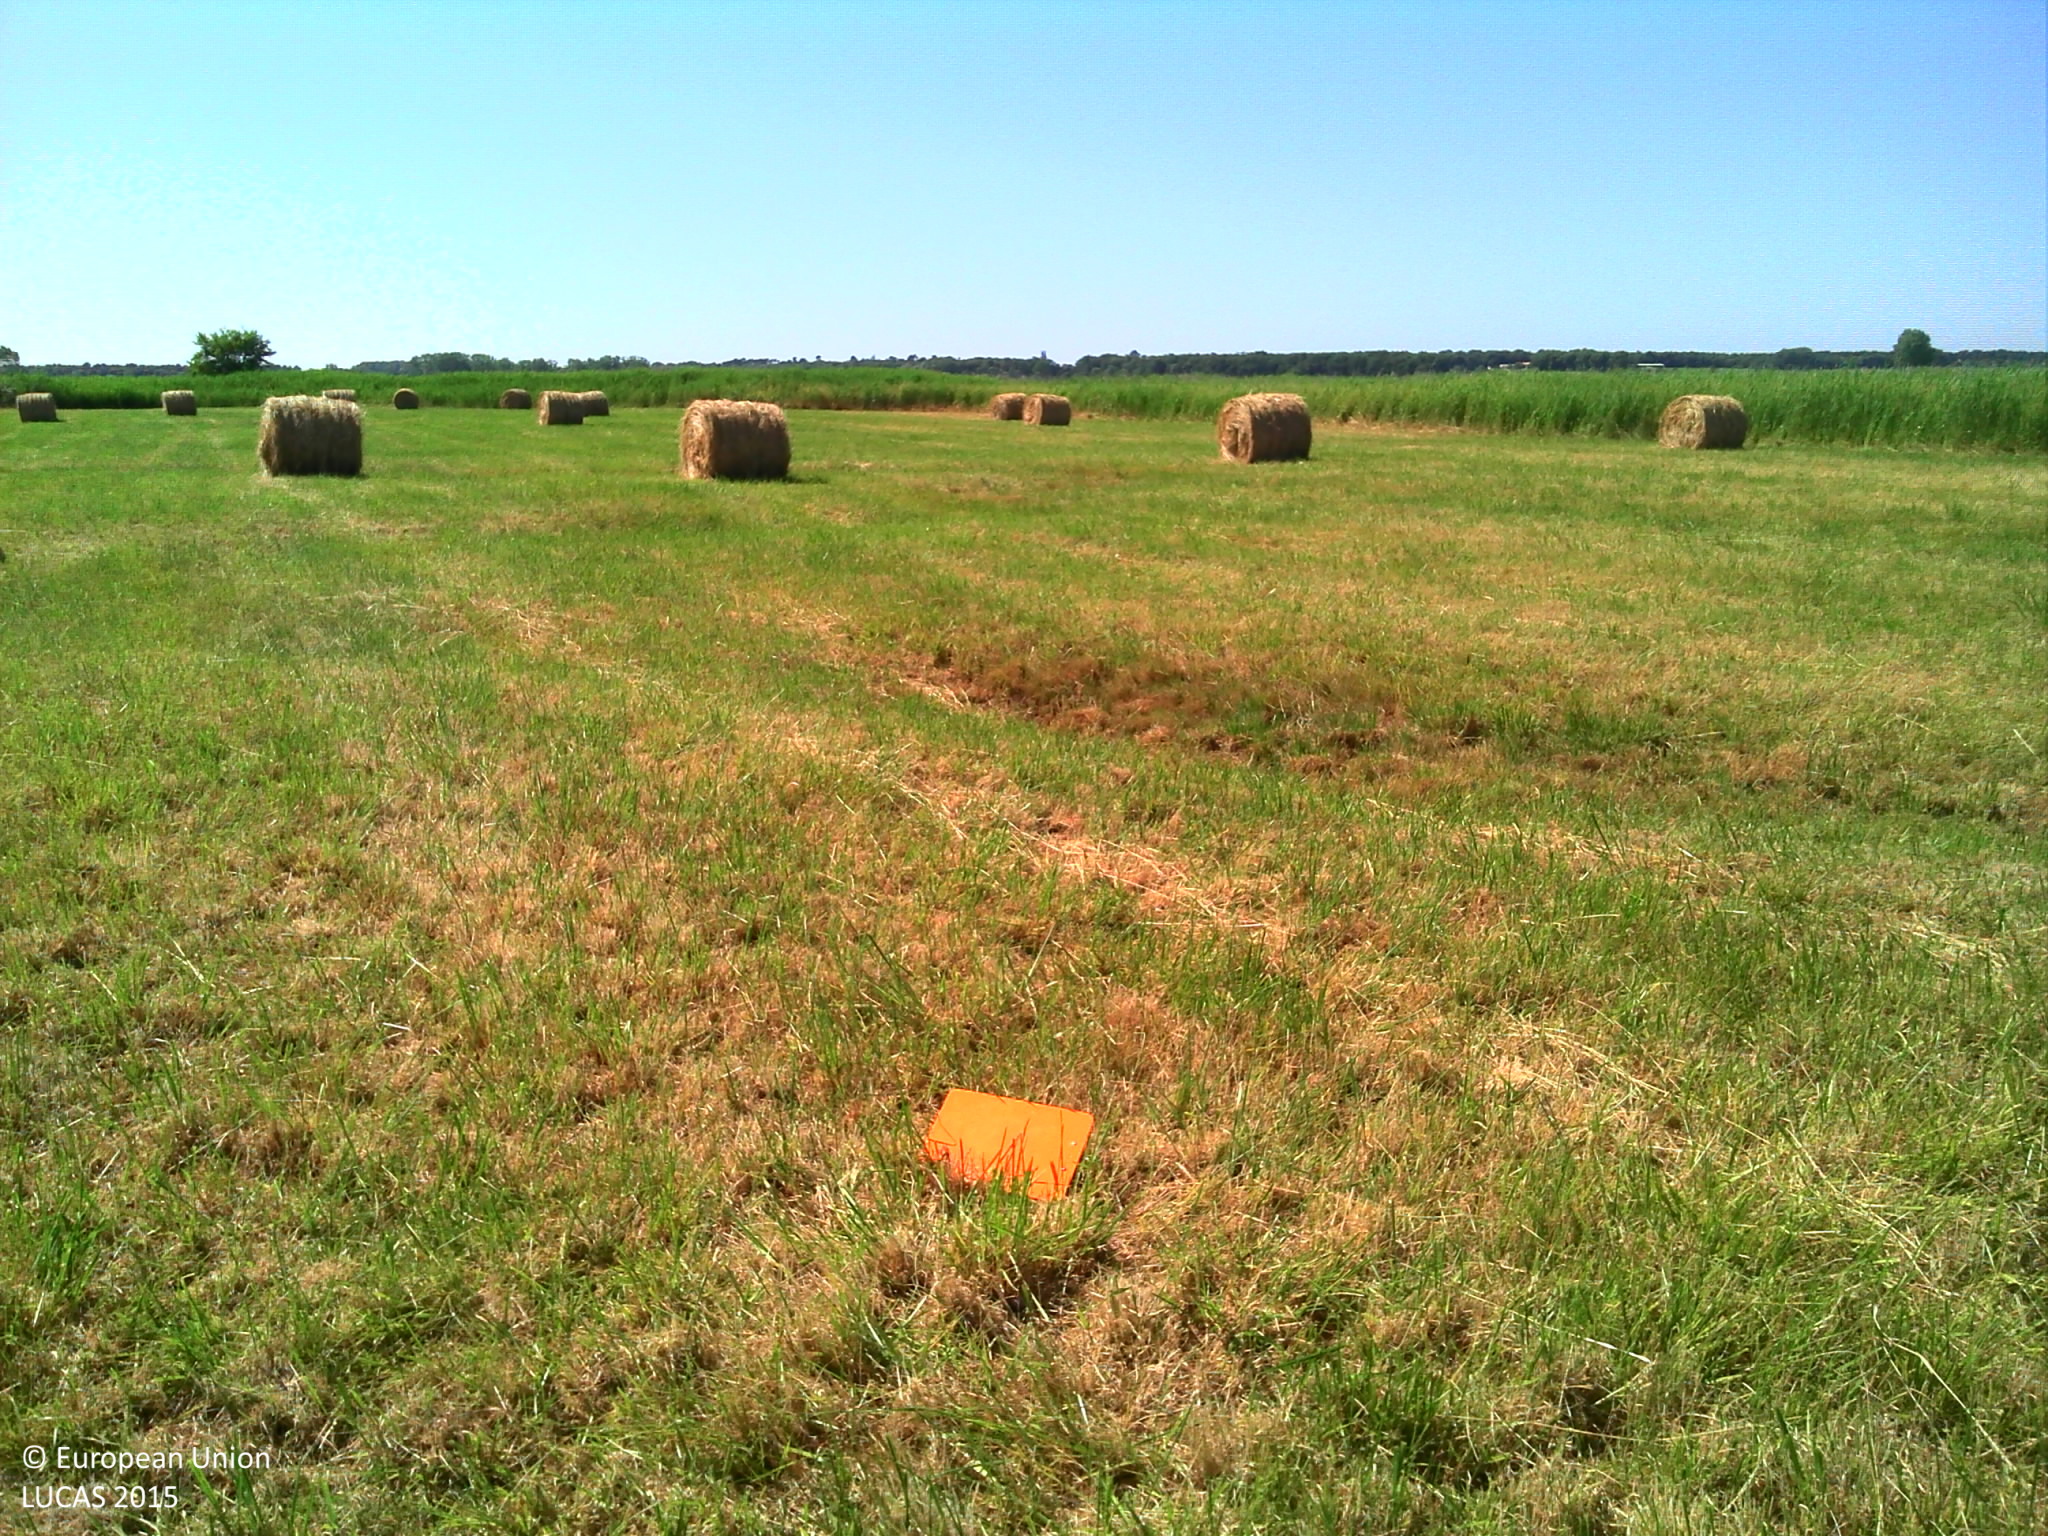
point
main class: Grassland
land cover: Grassland without tree/shrub cover
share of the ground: > 75 %
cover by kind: herbaceous plants 100 %
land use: Agriculture (excluding fallow land and kitchen gardens)
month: June
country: FR
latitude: 45.6976
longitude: -1.1122
